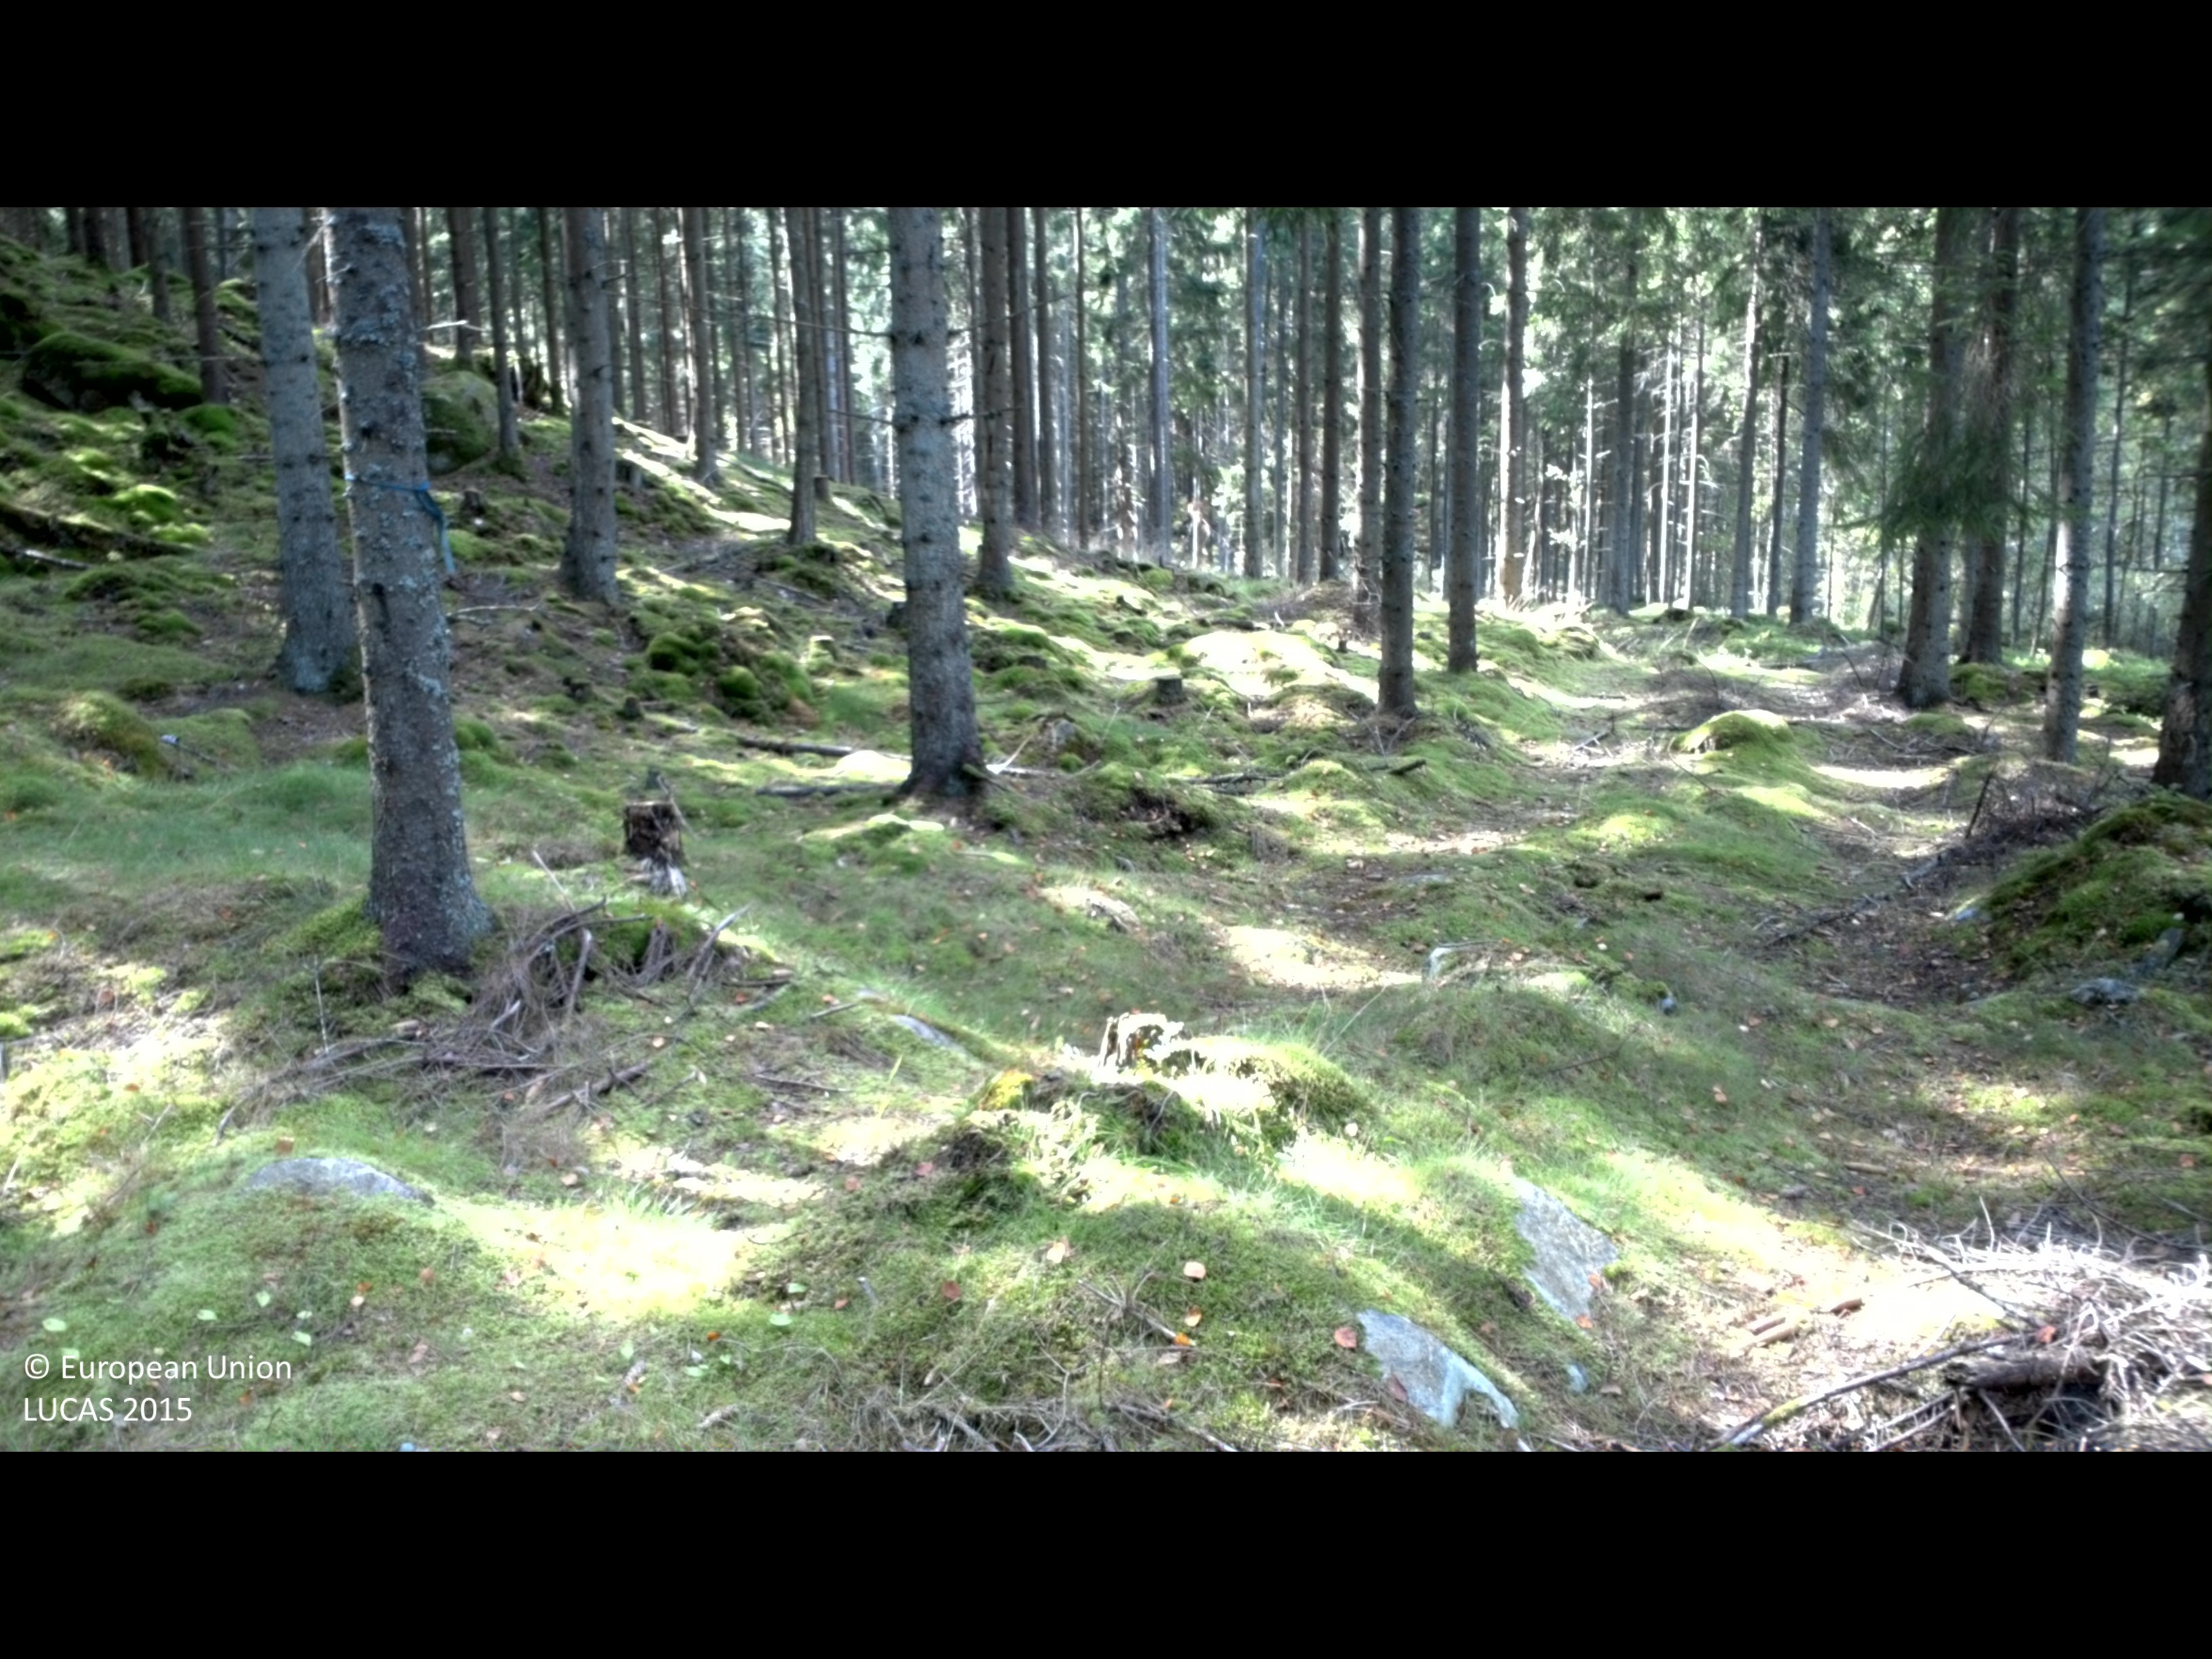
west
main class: Woodland
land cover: Spruce dominated coniferous woodland
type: boreal forest
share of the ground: > 75 %
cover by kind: coniferous forest trees 80 %, lichens and mosses 10 %, shrubs 5 %, herbaceous plants 5 %
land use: Forestry
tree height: > 5 m
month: August
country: SE
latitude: 56.2965
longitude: 14.2797
